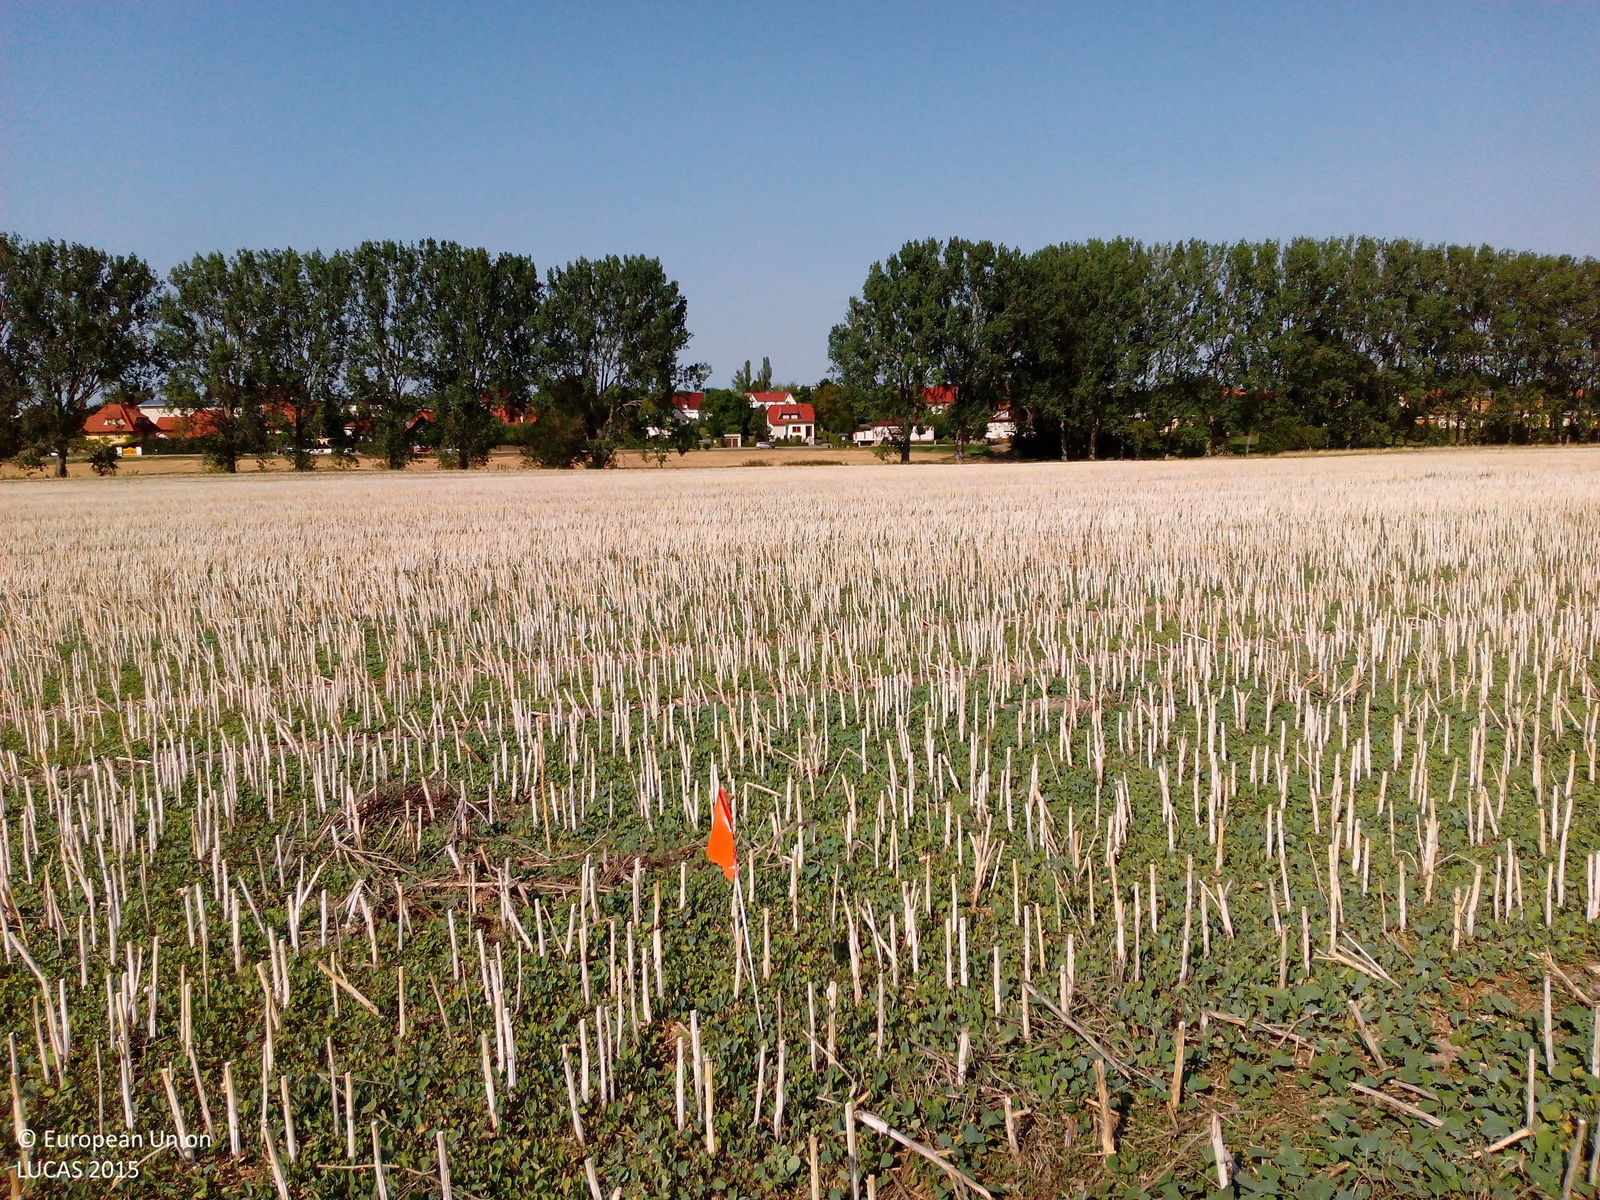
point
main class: Cropland
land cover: Rape and turnip rape
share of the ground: 10 - 25 %
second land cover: Other root crops
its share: 50 - 75 %
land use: Agriculture (excluding fallow land and kitchen gardens)
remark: Harvested field
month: August
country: DE
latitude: 51.8691
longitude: 11.0889
